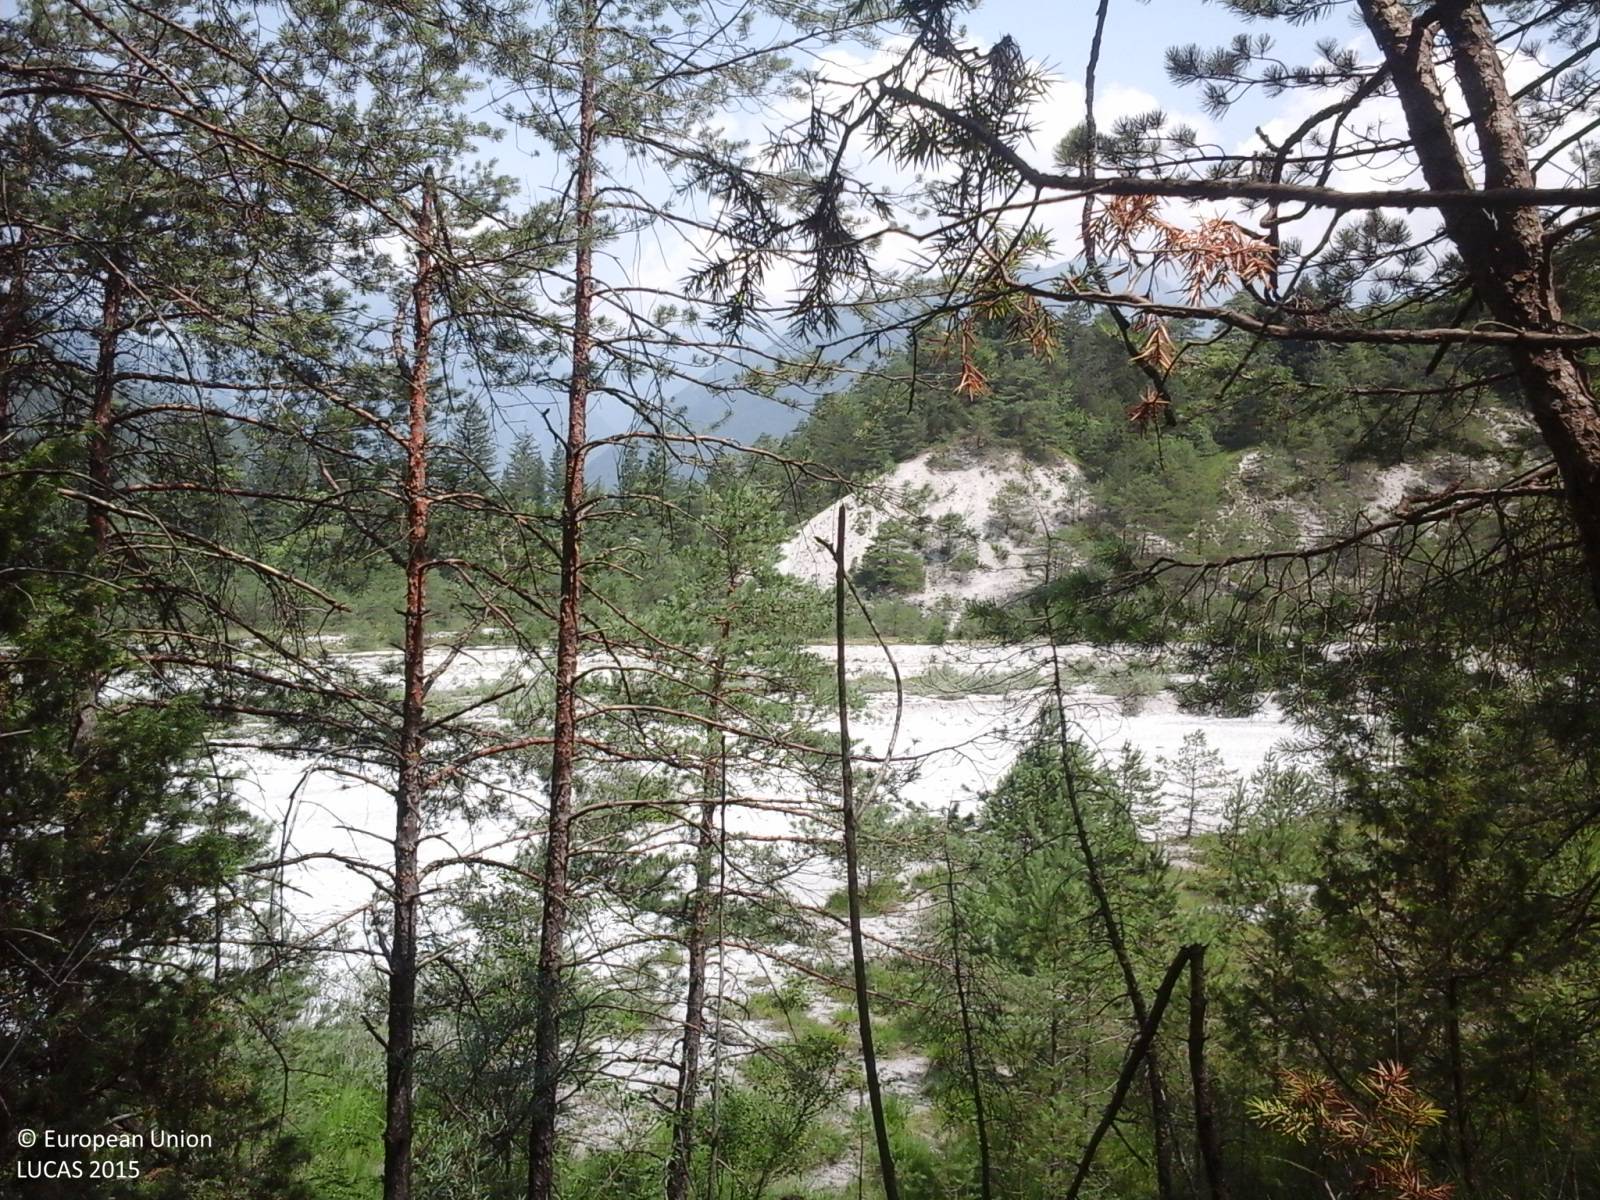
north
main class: Woodland
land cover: Pine dominated coniferous woodland
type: coniferous forest of the mediterranean region
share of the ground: > 75 %
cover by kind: coniferous forest trees 70 %, broadleaved forest trees 10 %, shrubs 10 %, herbaceous plants 10 %
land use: Forestry
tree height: > 5 m
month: July
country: IT
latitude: 46.2789
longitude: 12.7871
